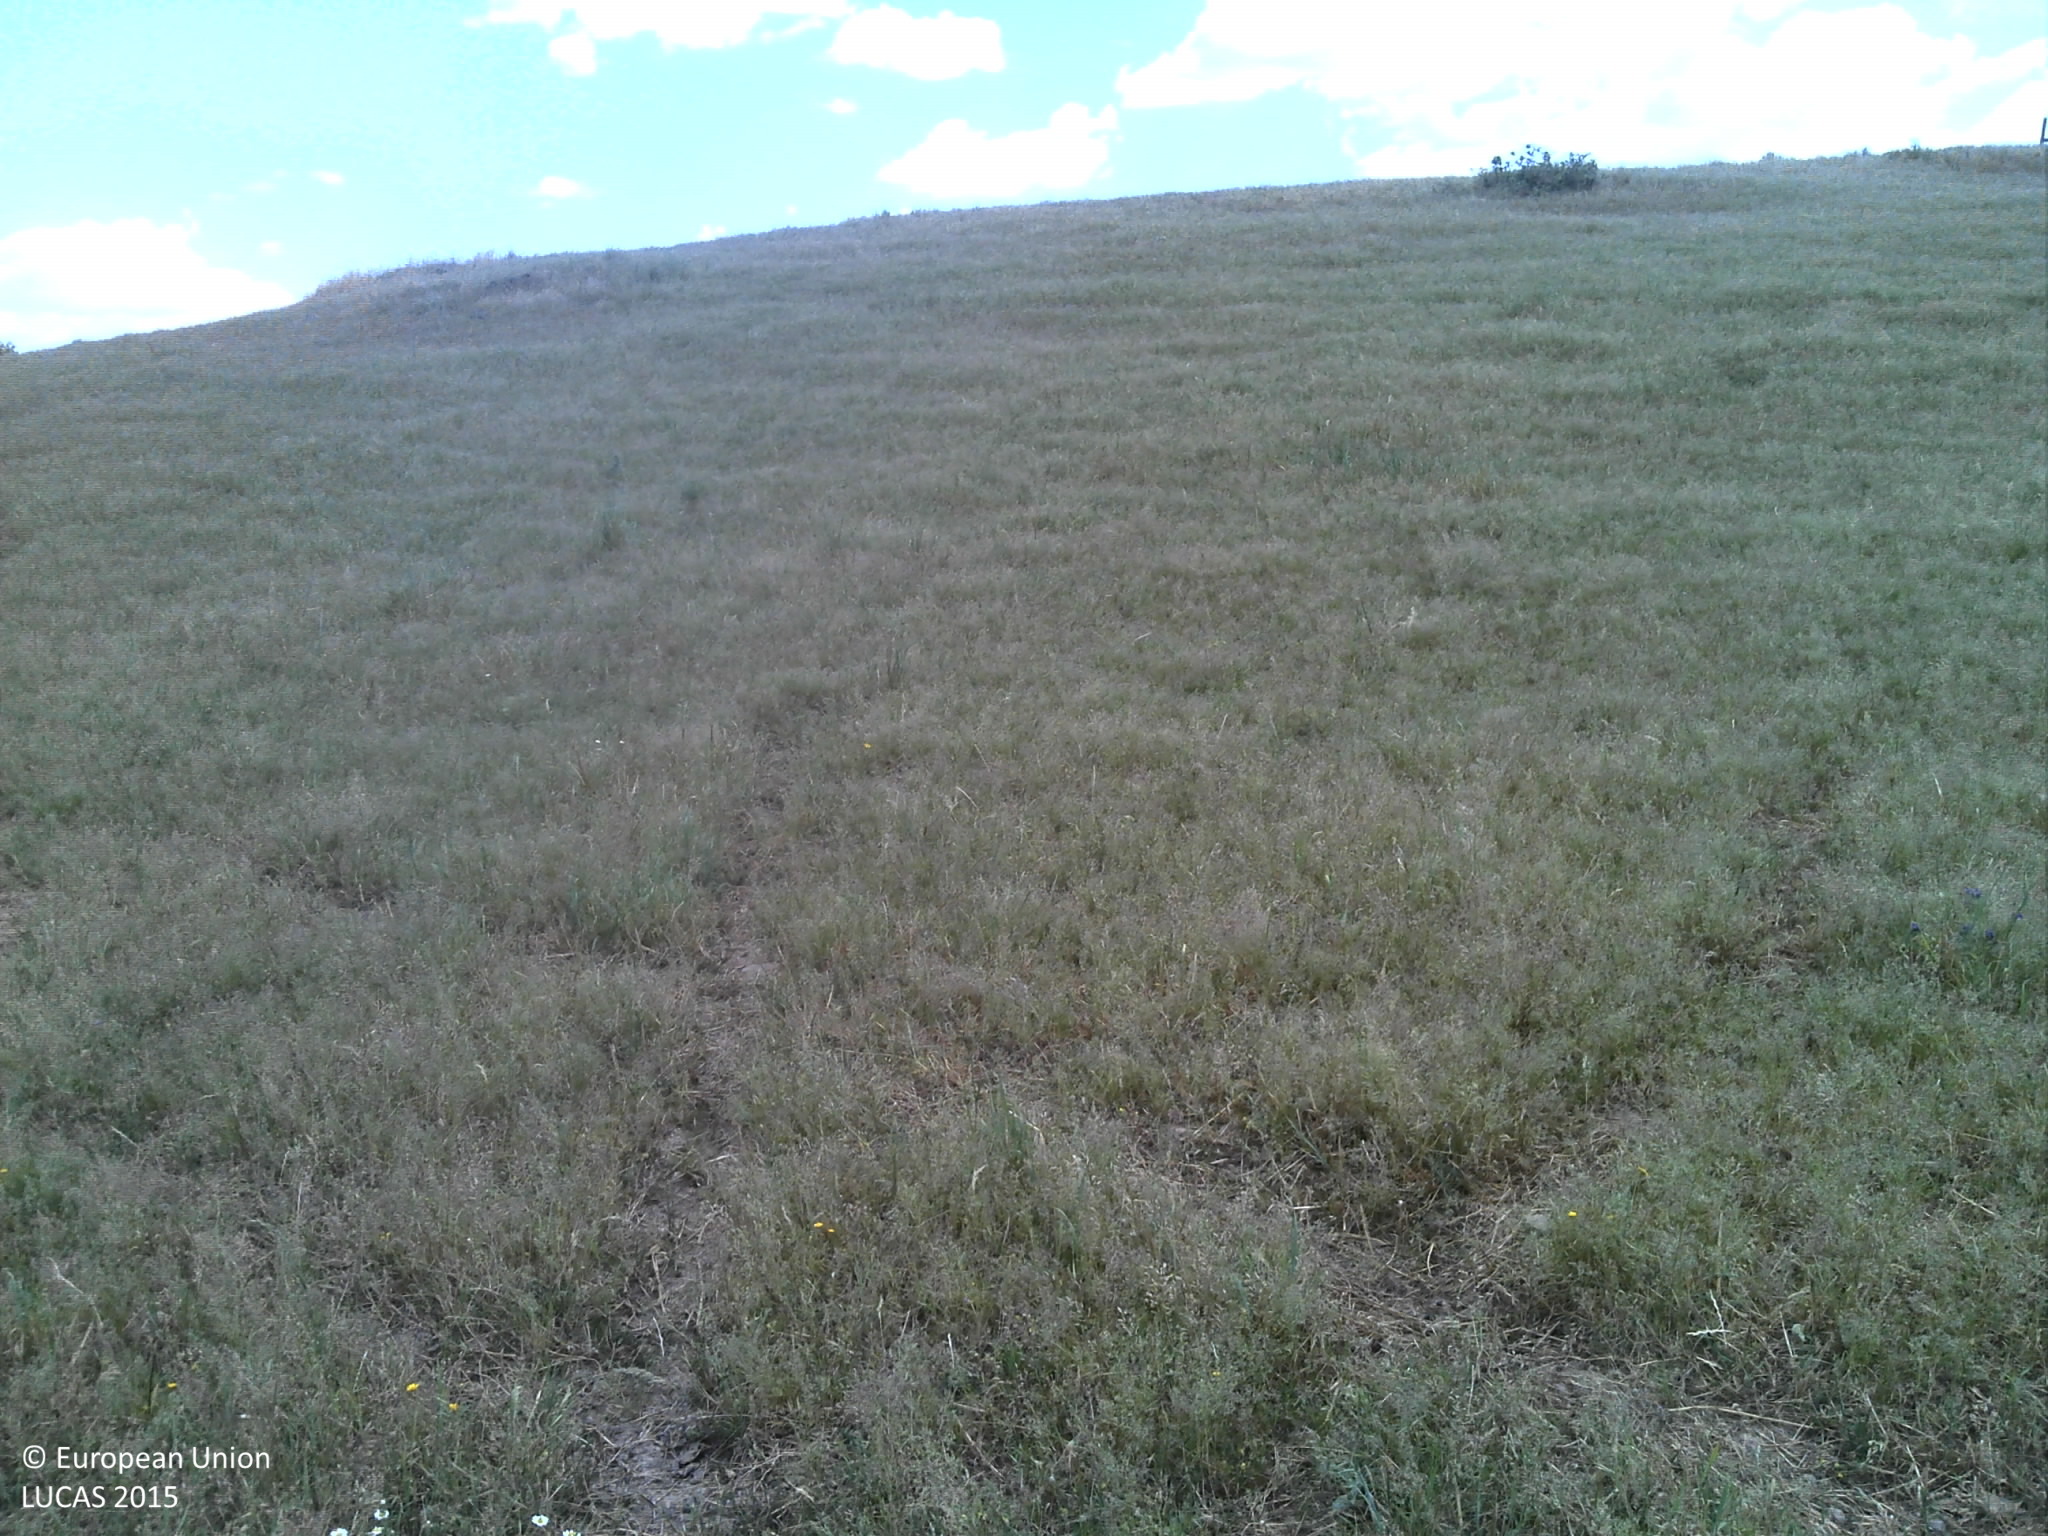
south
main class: Grassland
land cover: Grassland without tree/shrub cover
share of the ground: 50 - 75 %
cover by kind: herbaceous plants 70 %, unconsolidated bare surface 30 %
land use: Agriculture (excluding fallow land and kitchen gardens)
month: May
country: PT
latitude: 37.9950
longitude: -8.5717
